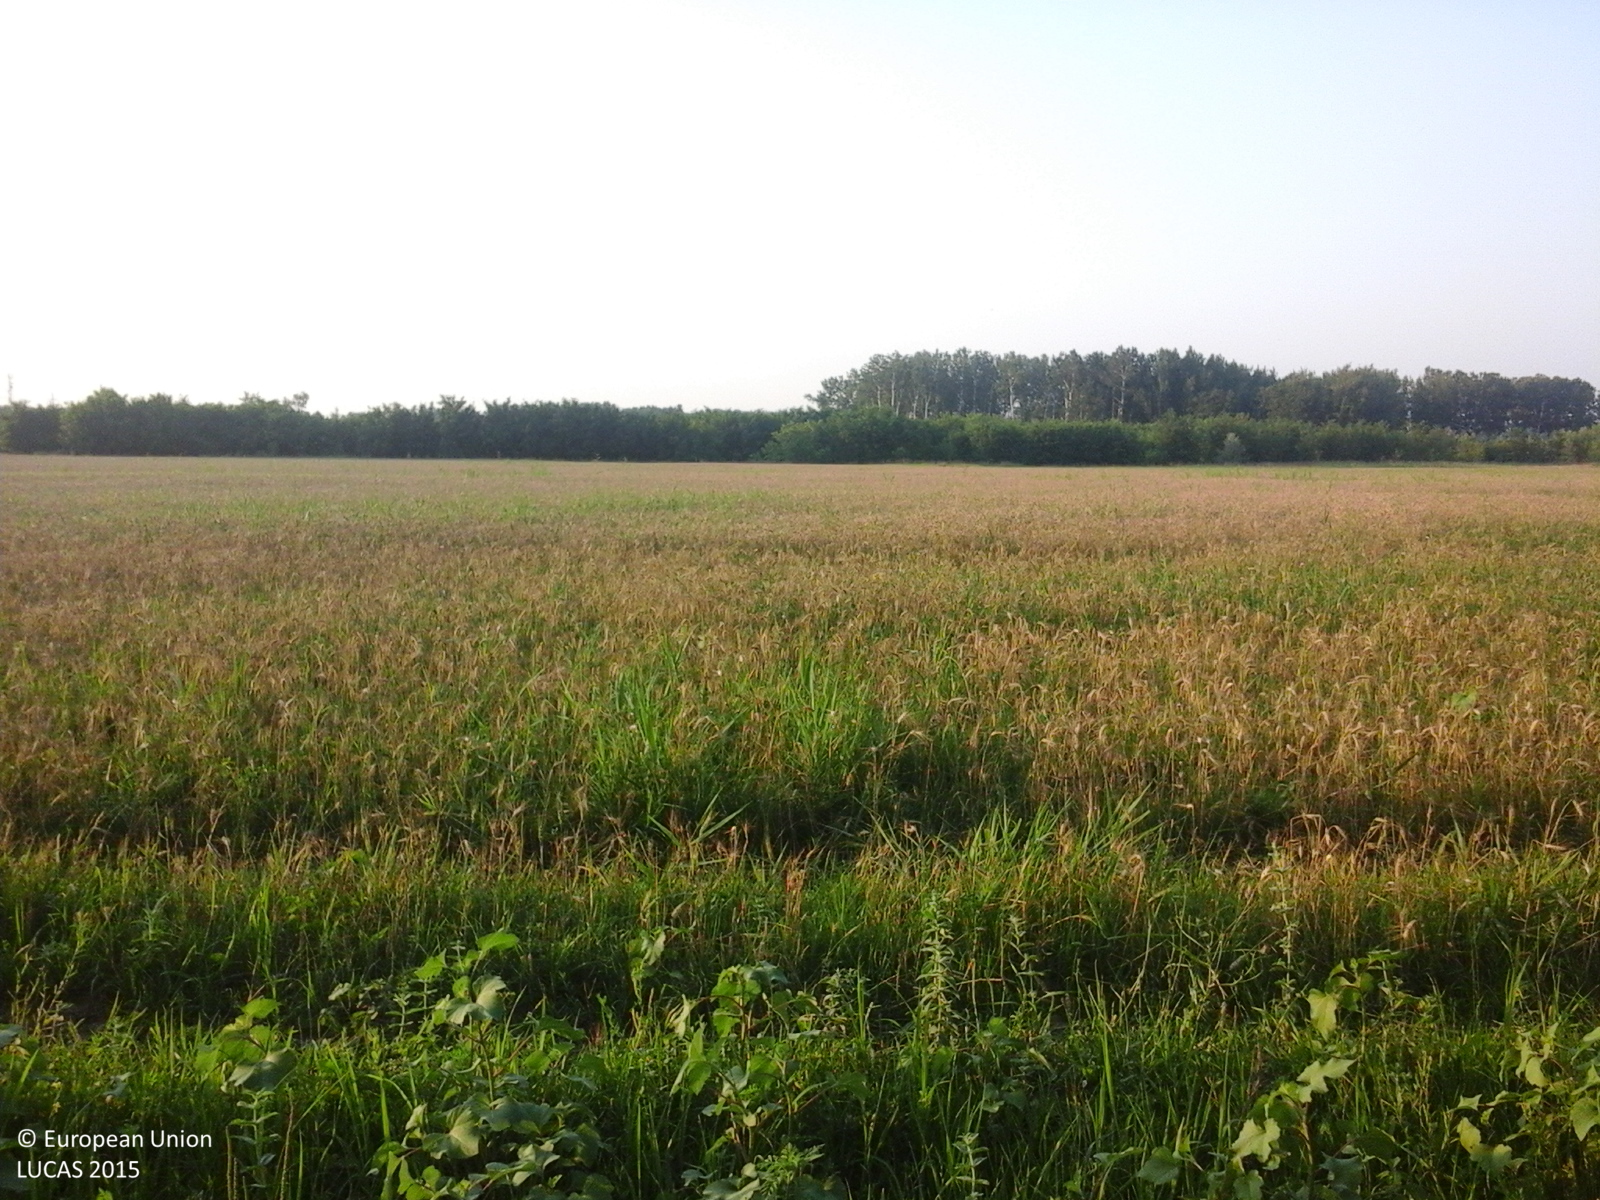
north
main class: Woodland
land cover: Broadleaved woodland
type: non-riverine alder, birch or aspen forest
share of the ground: > 75 %
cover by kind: broadleaved forest trees 100 %
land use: Forestry
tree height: > 5 m
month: July
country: RO
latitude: 44.7017
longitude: 25.6068
